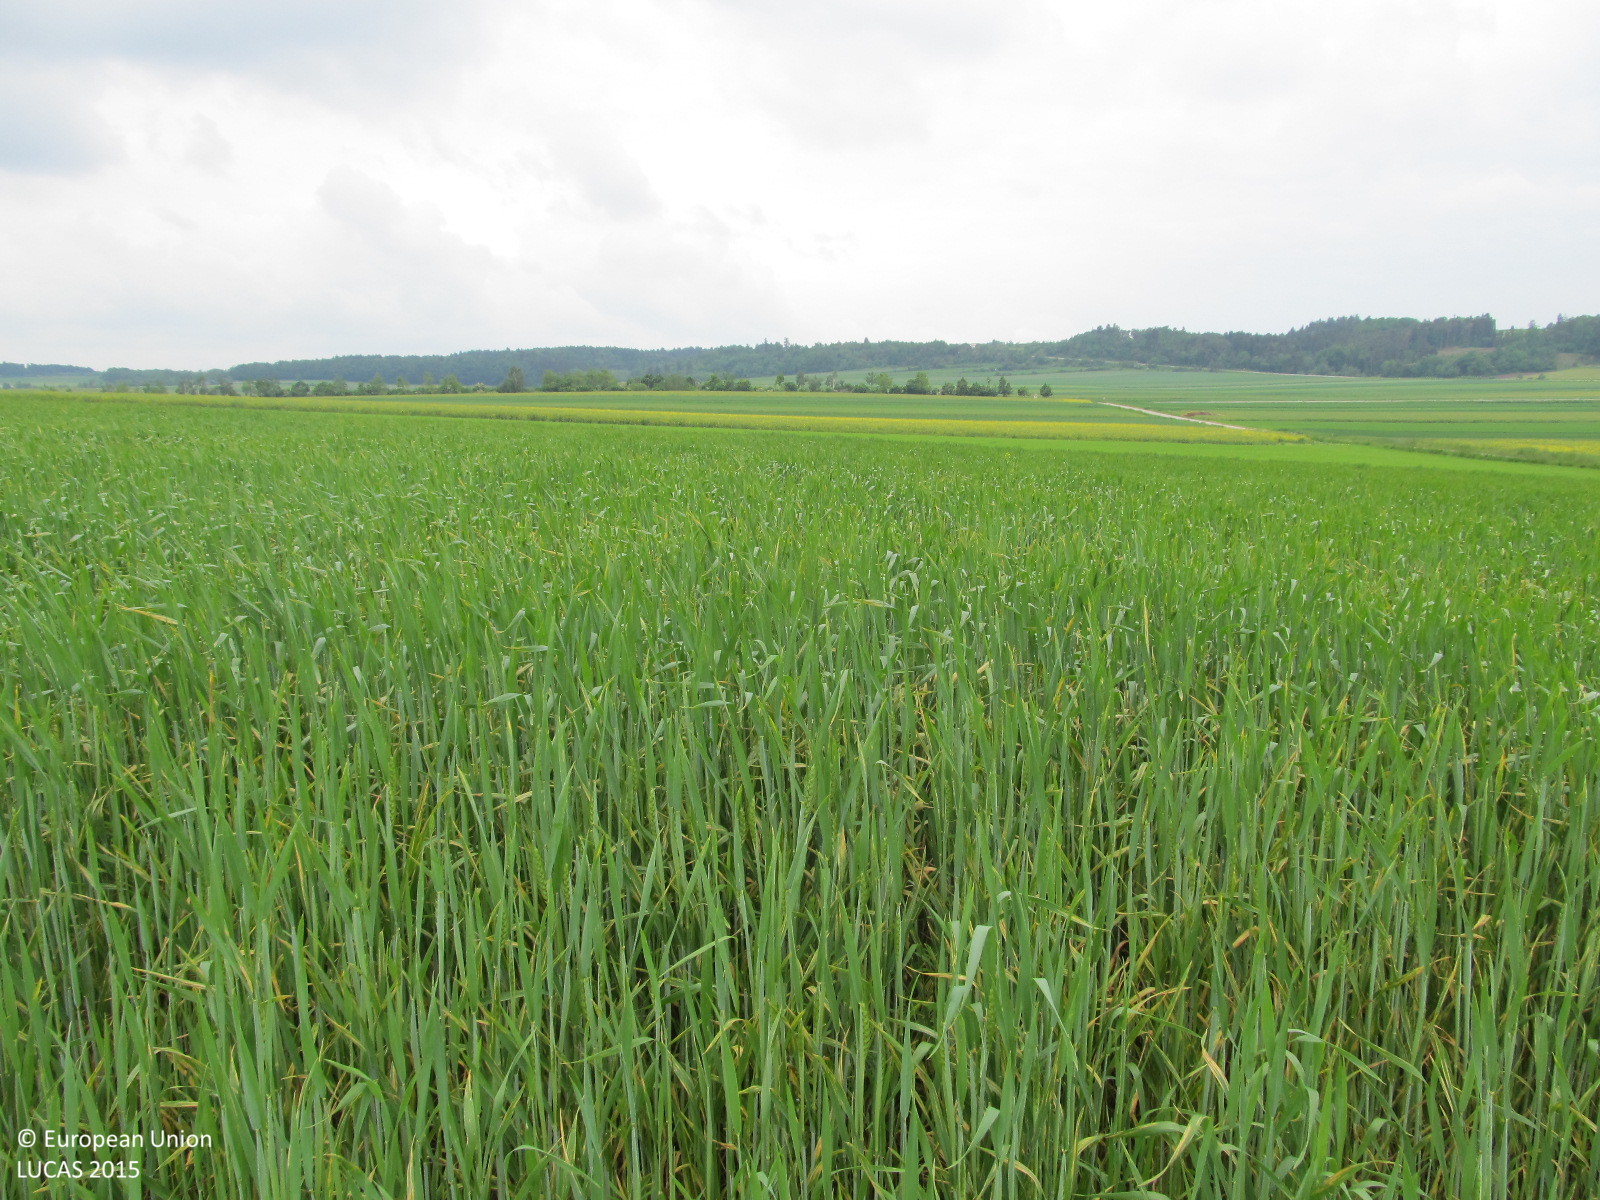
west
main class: Cropland
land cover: Common wheat
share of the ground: > 75 %
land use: Agriculture (excluding fallow land and kitchen gardens)
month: May
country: AT
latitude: 48.6646
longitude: 15.4748
